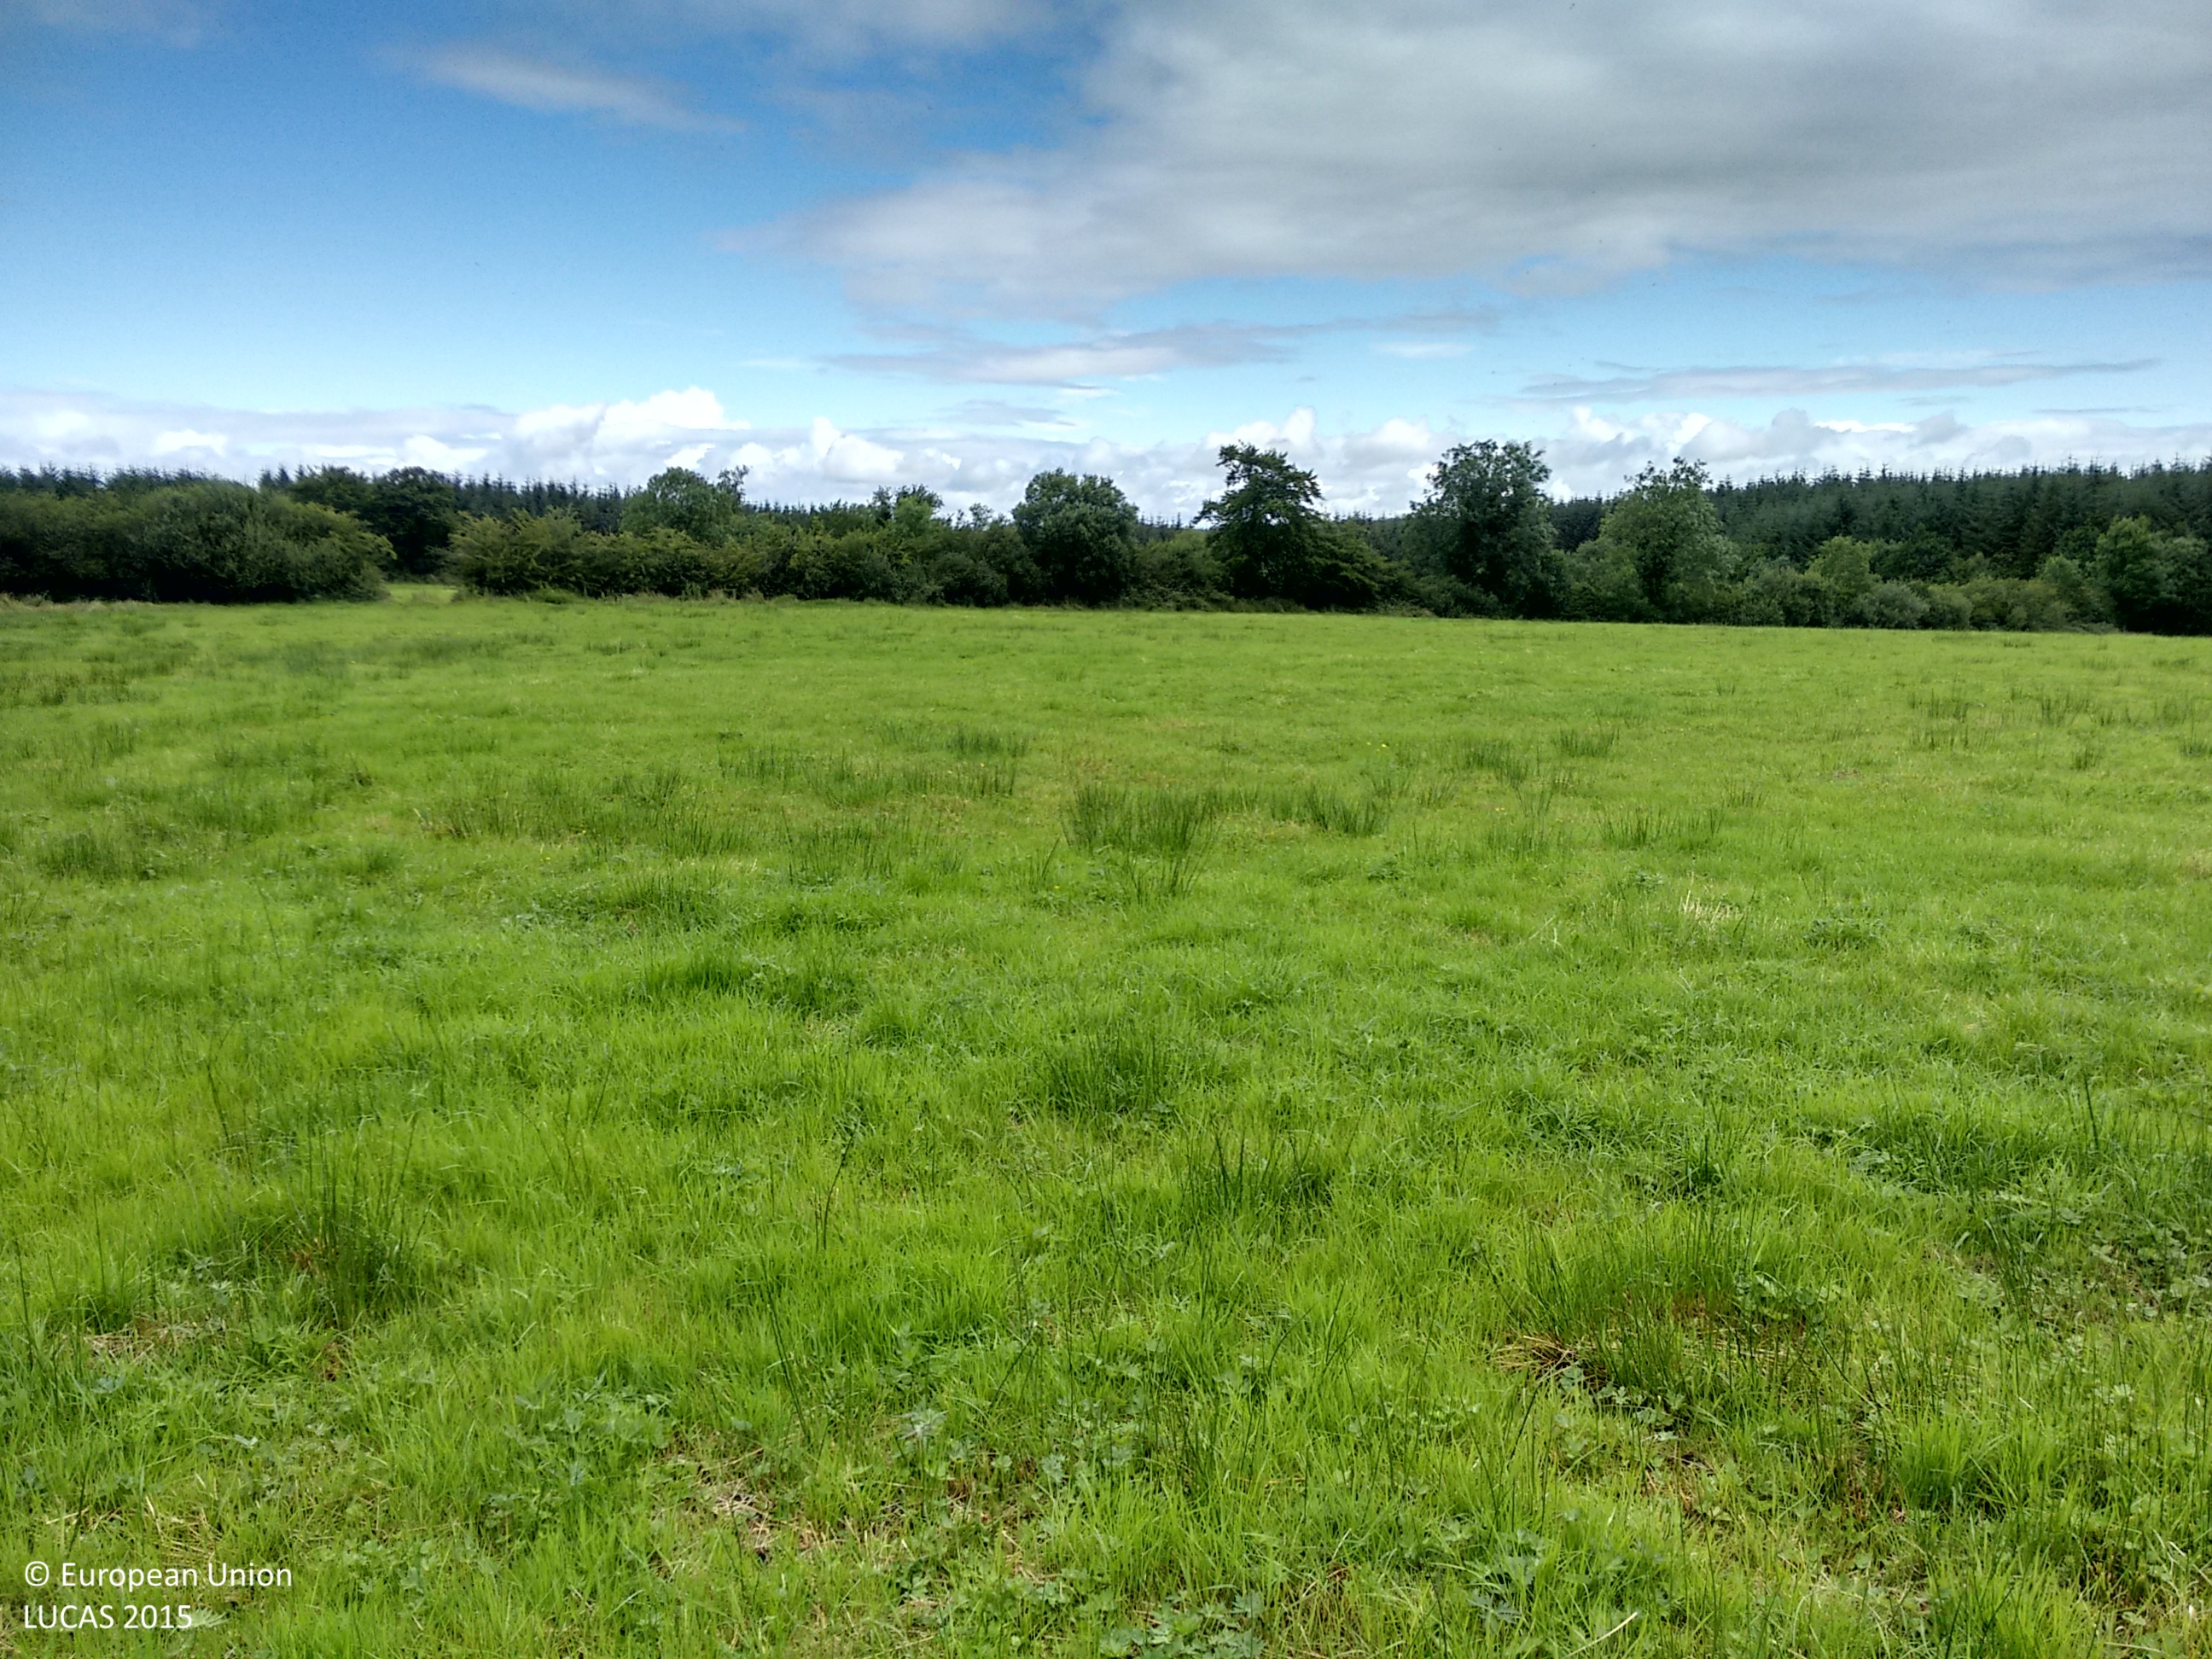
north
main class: Grassland
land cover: Grassland without tree/shrub cover
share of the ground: > 75 %
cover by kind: herbaceous plants 95 %, shrubs 5 %
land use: Agriculture (excluding fallow land and kitchen gardens)
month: July
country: IE
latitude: 53.8452
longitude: -7.7514
